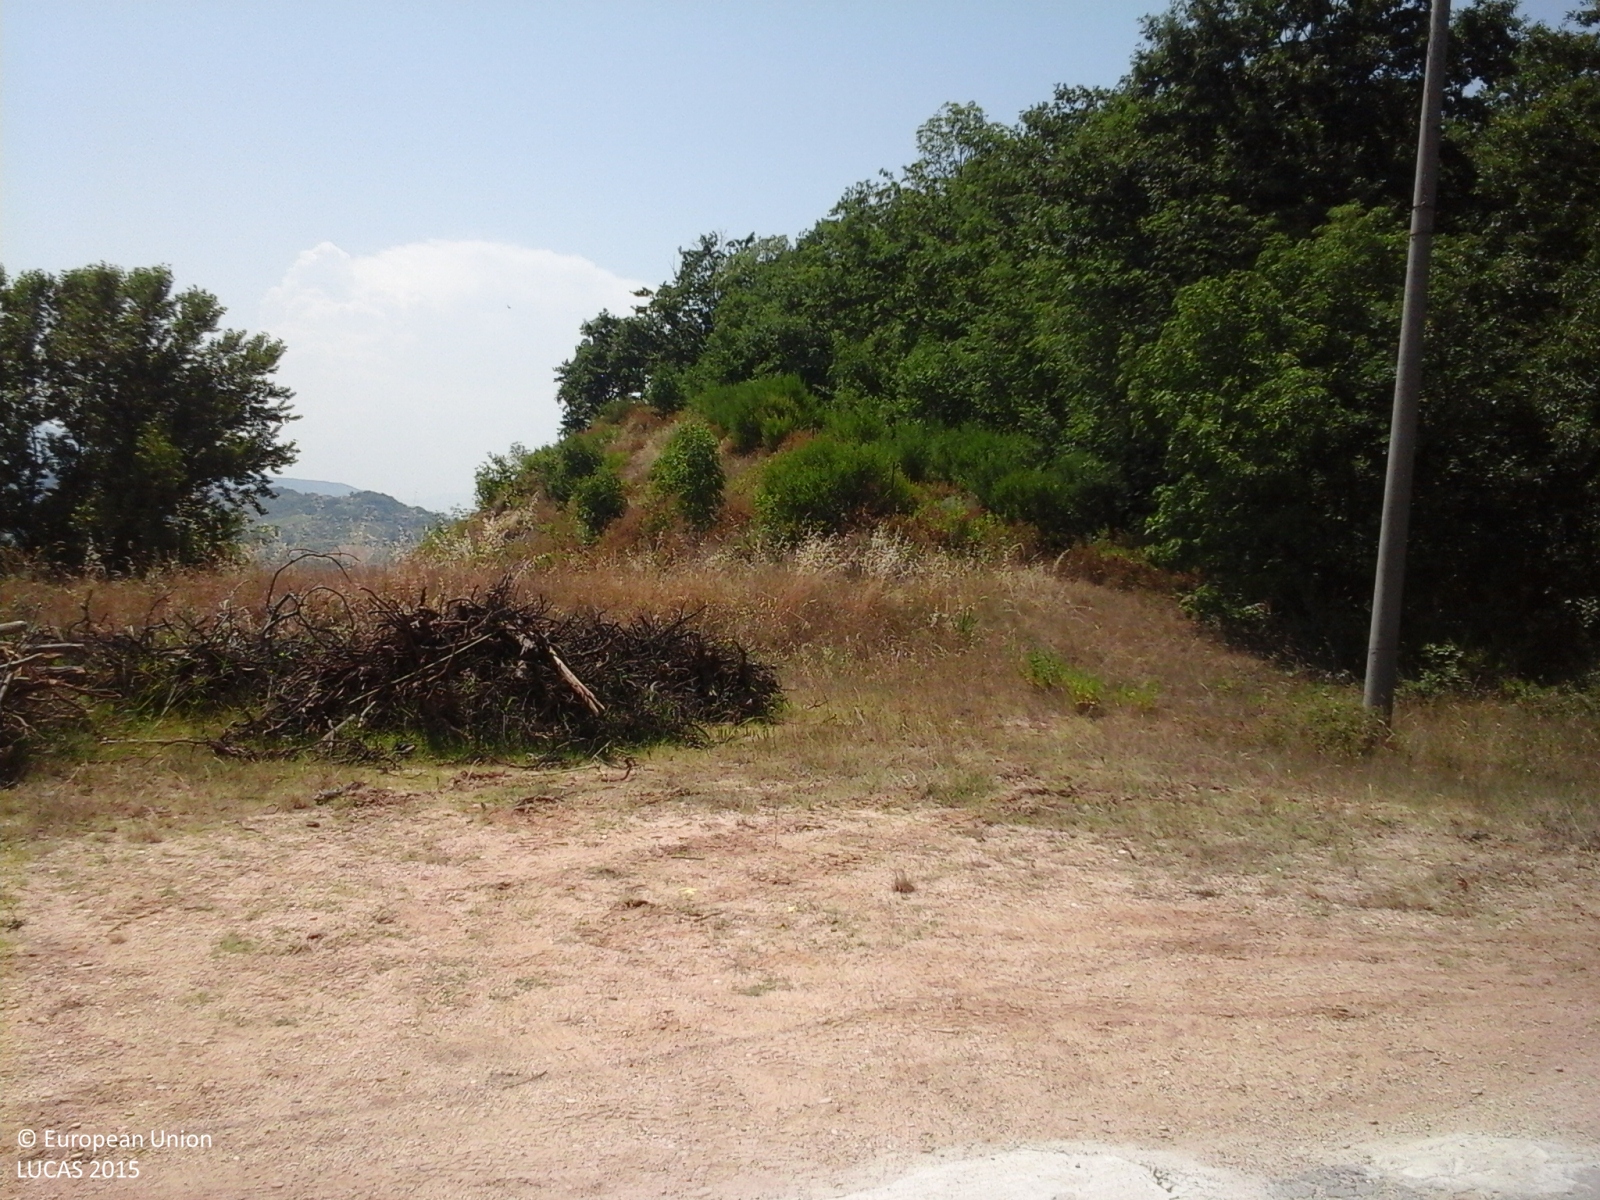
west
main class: Cropland
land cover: Tomatoes
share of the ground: > 75 %
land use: Agriculture (excluding fallow land and kitchen gardens)
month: July
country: IT
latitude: 42.2577
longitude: 14.2417
